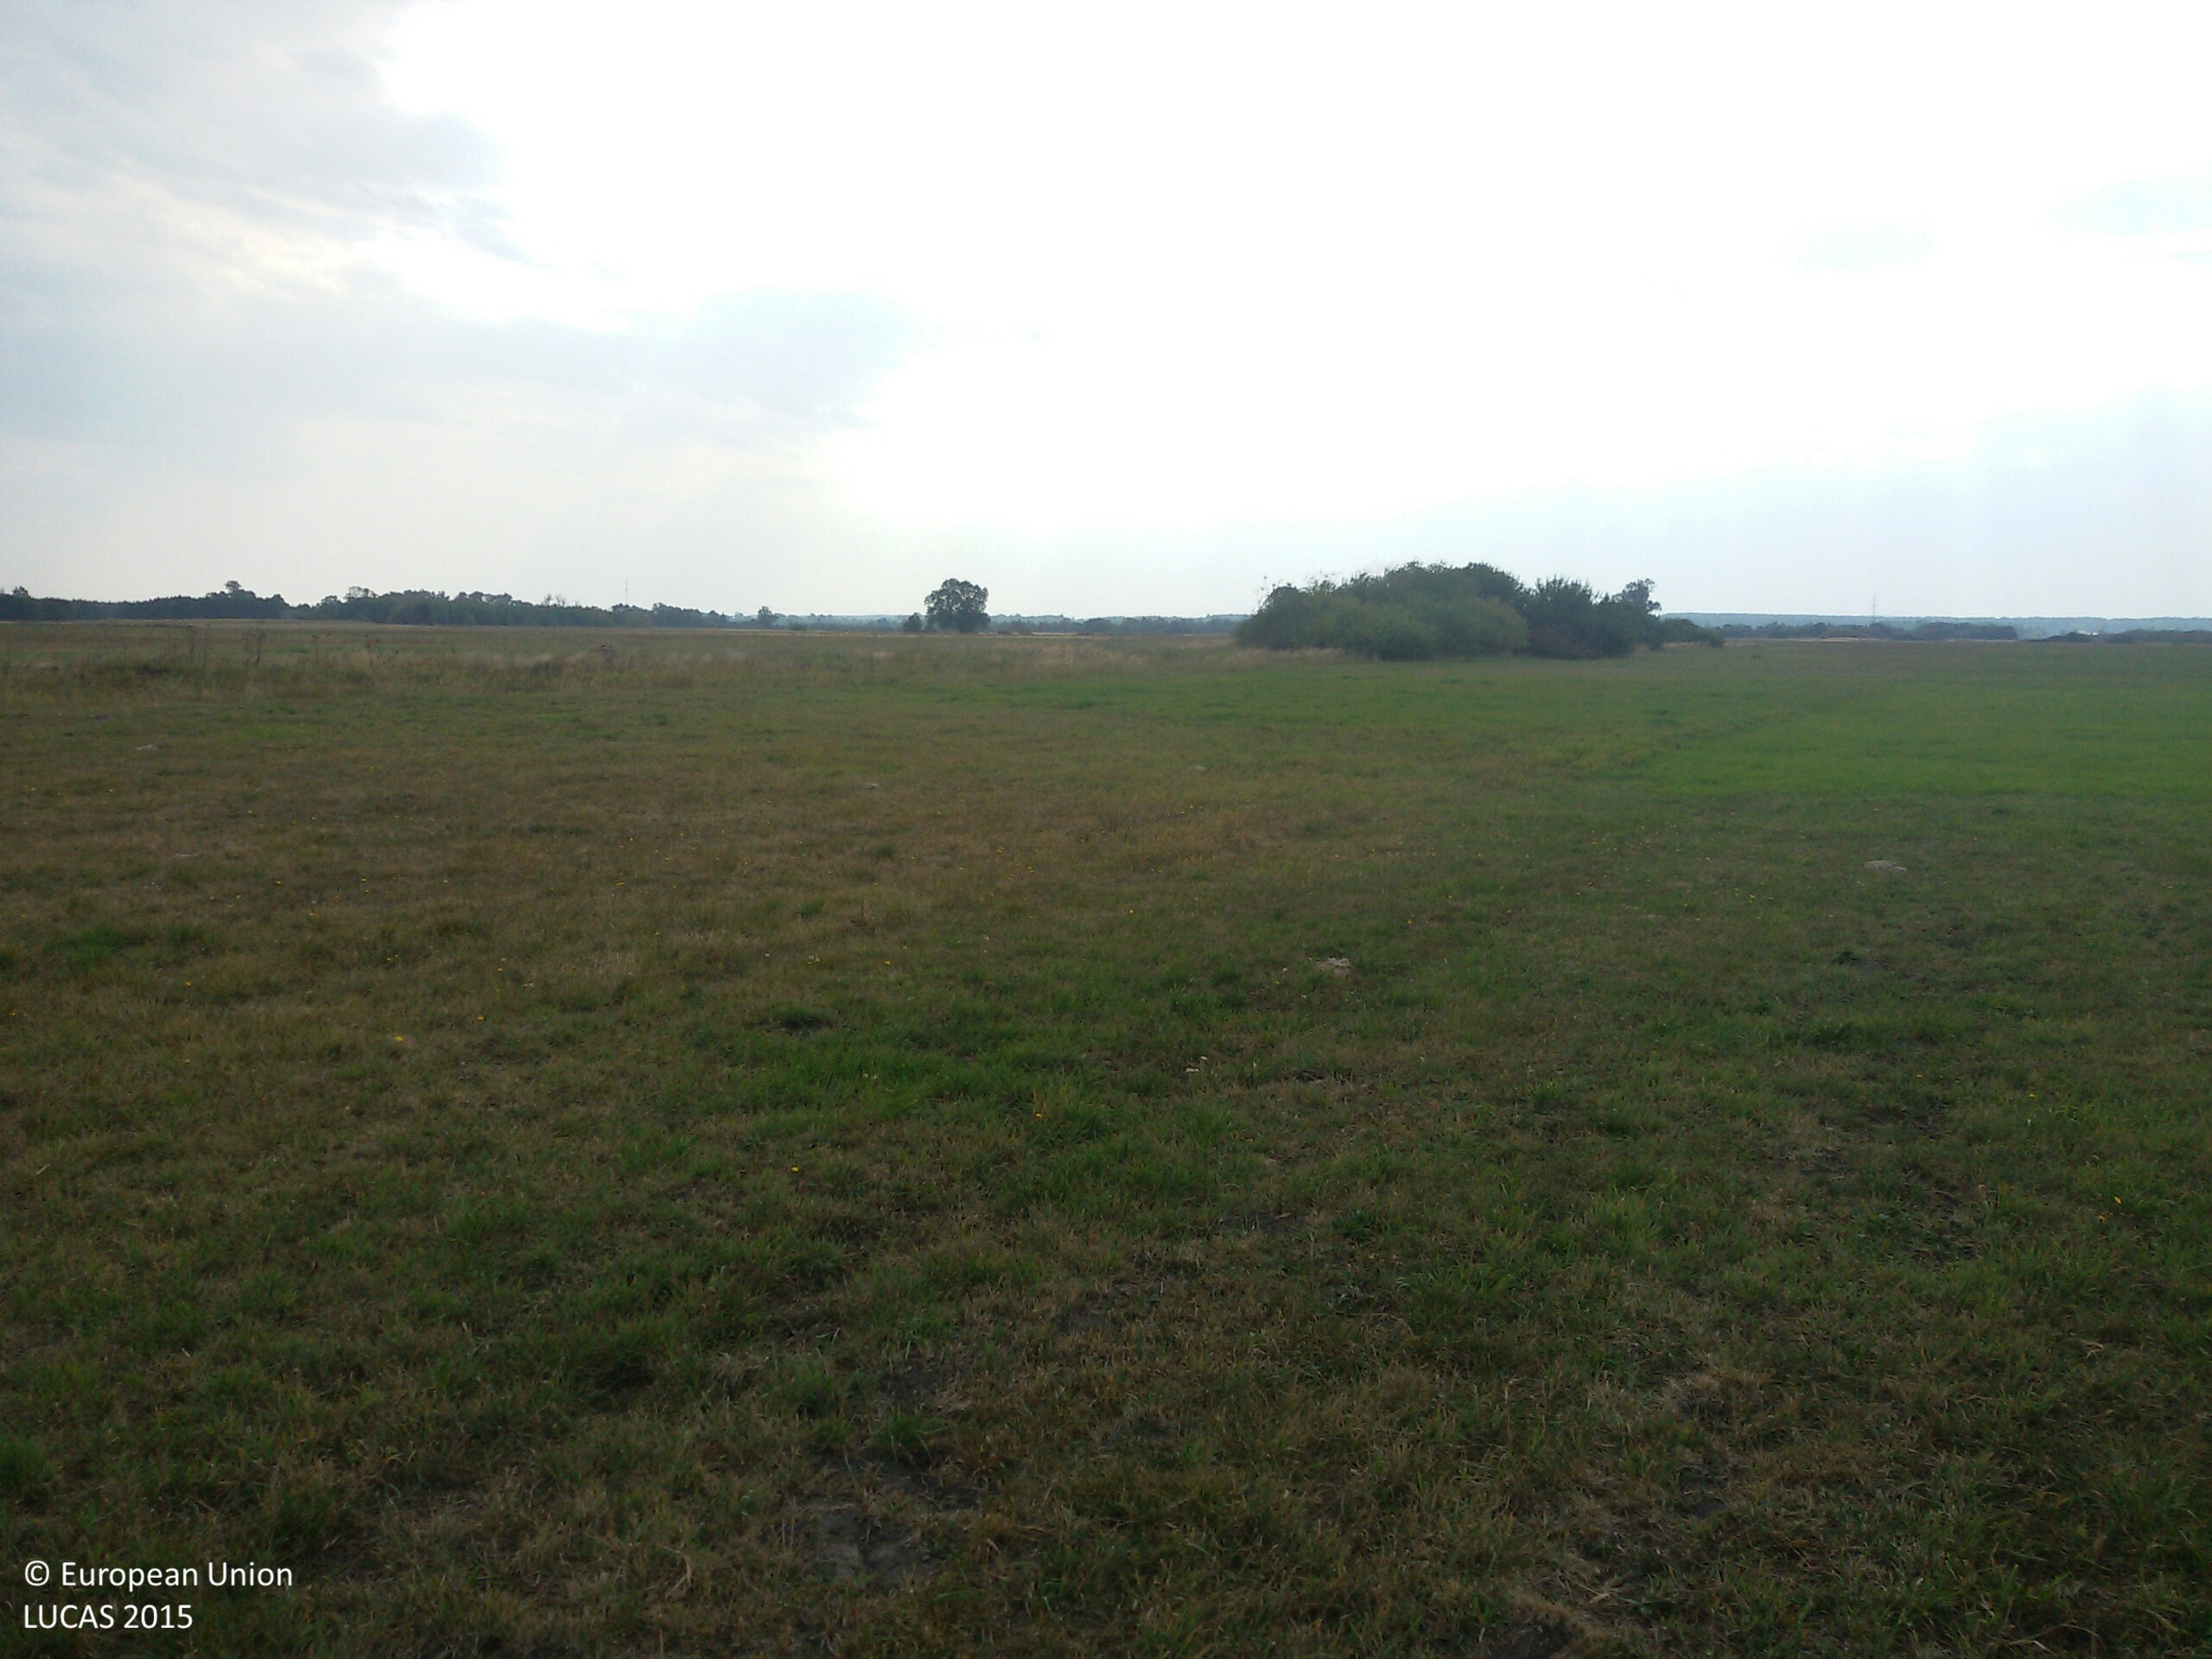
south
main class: Grassland
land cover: Grassland without tree/shrub cover
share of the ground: > 75 %
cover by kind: herbaceous plants 100 %
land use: Agriculture (excluding fallow land and kitchen gardens)
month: September
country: PL
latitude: 50.7921
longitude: 19.6044
